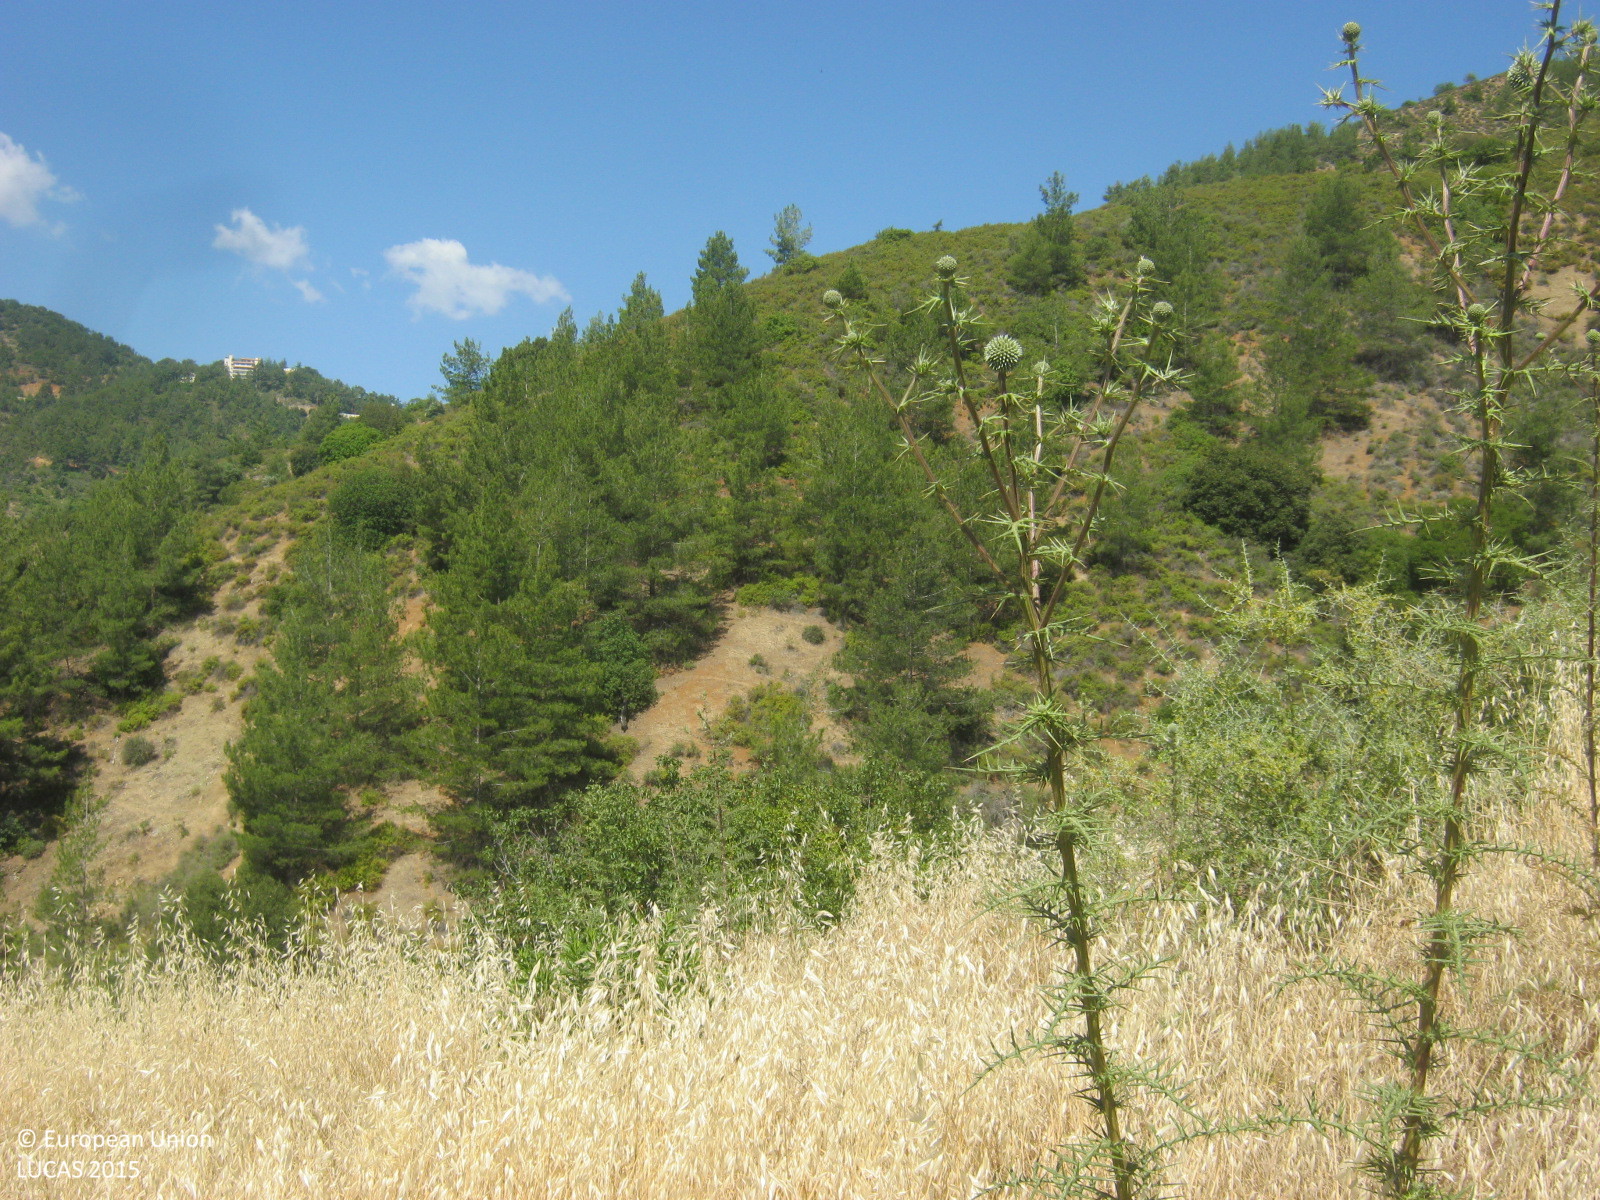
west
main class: Shrubland
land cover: Shrubland without tree cover
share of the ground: 25 - 50 %
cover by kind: herbaceous plants 60 %, shrubs 30 %, unconsolidated bare surface 10 %
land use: Semi-natural and natural areas not in use
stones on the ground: 25 - 50 %
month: June
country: CY
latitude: 35.0092
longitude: 32.8173
